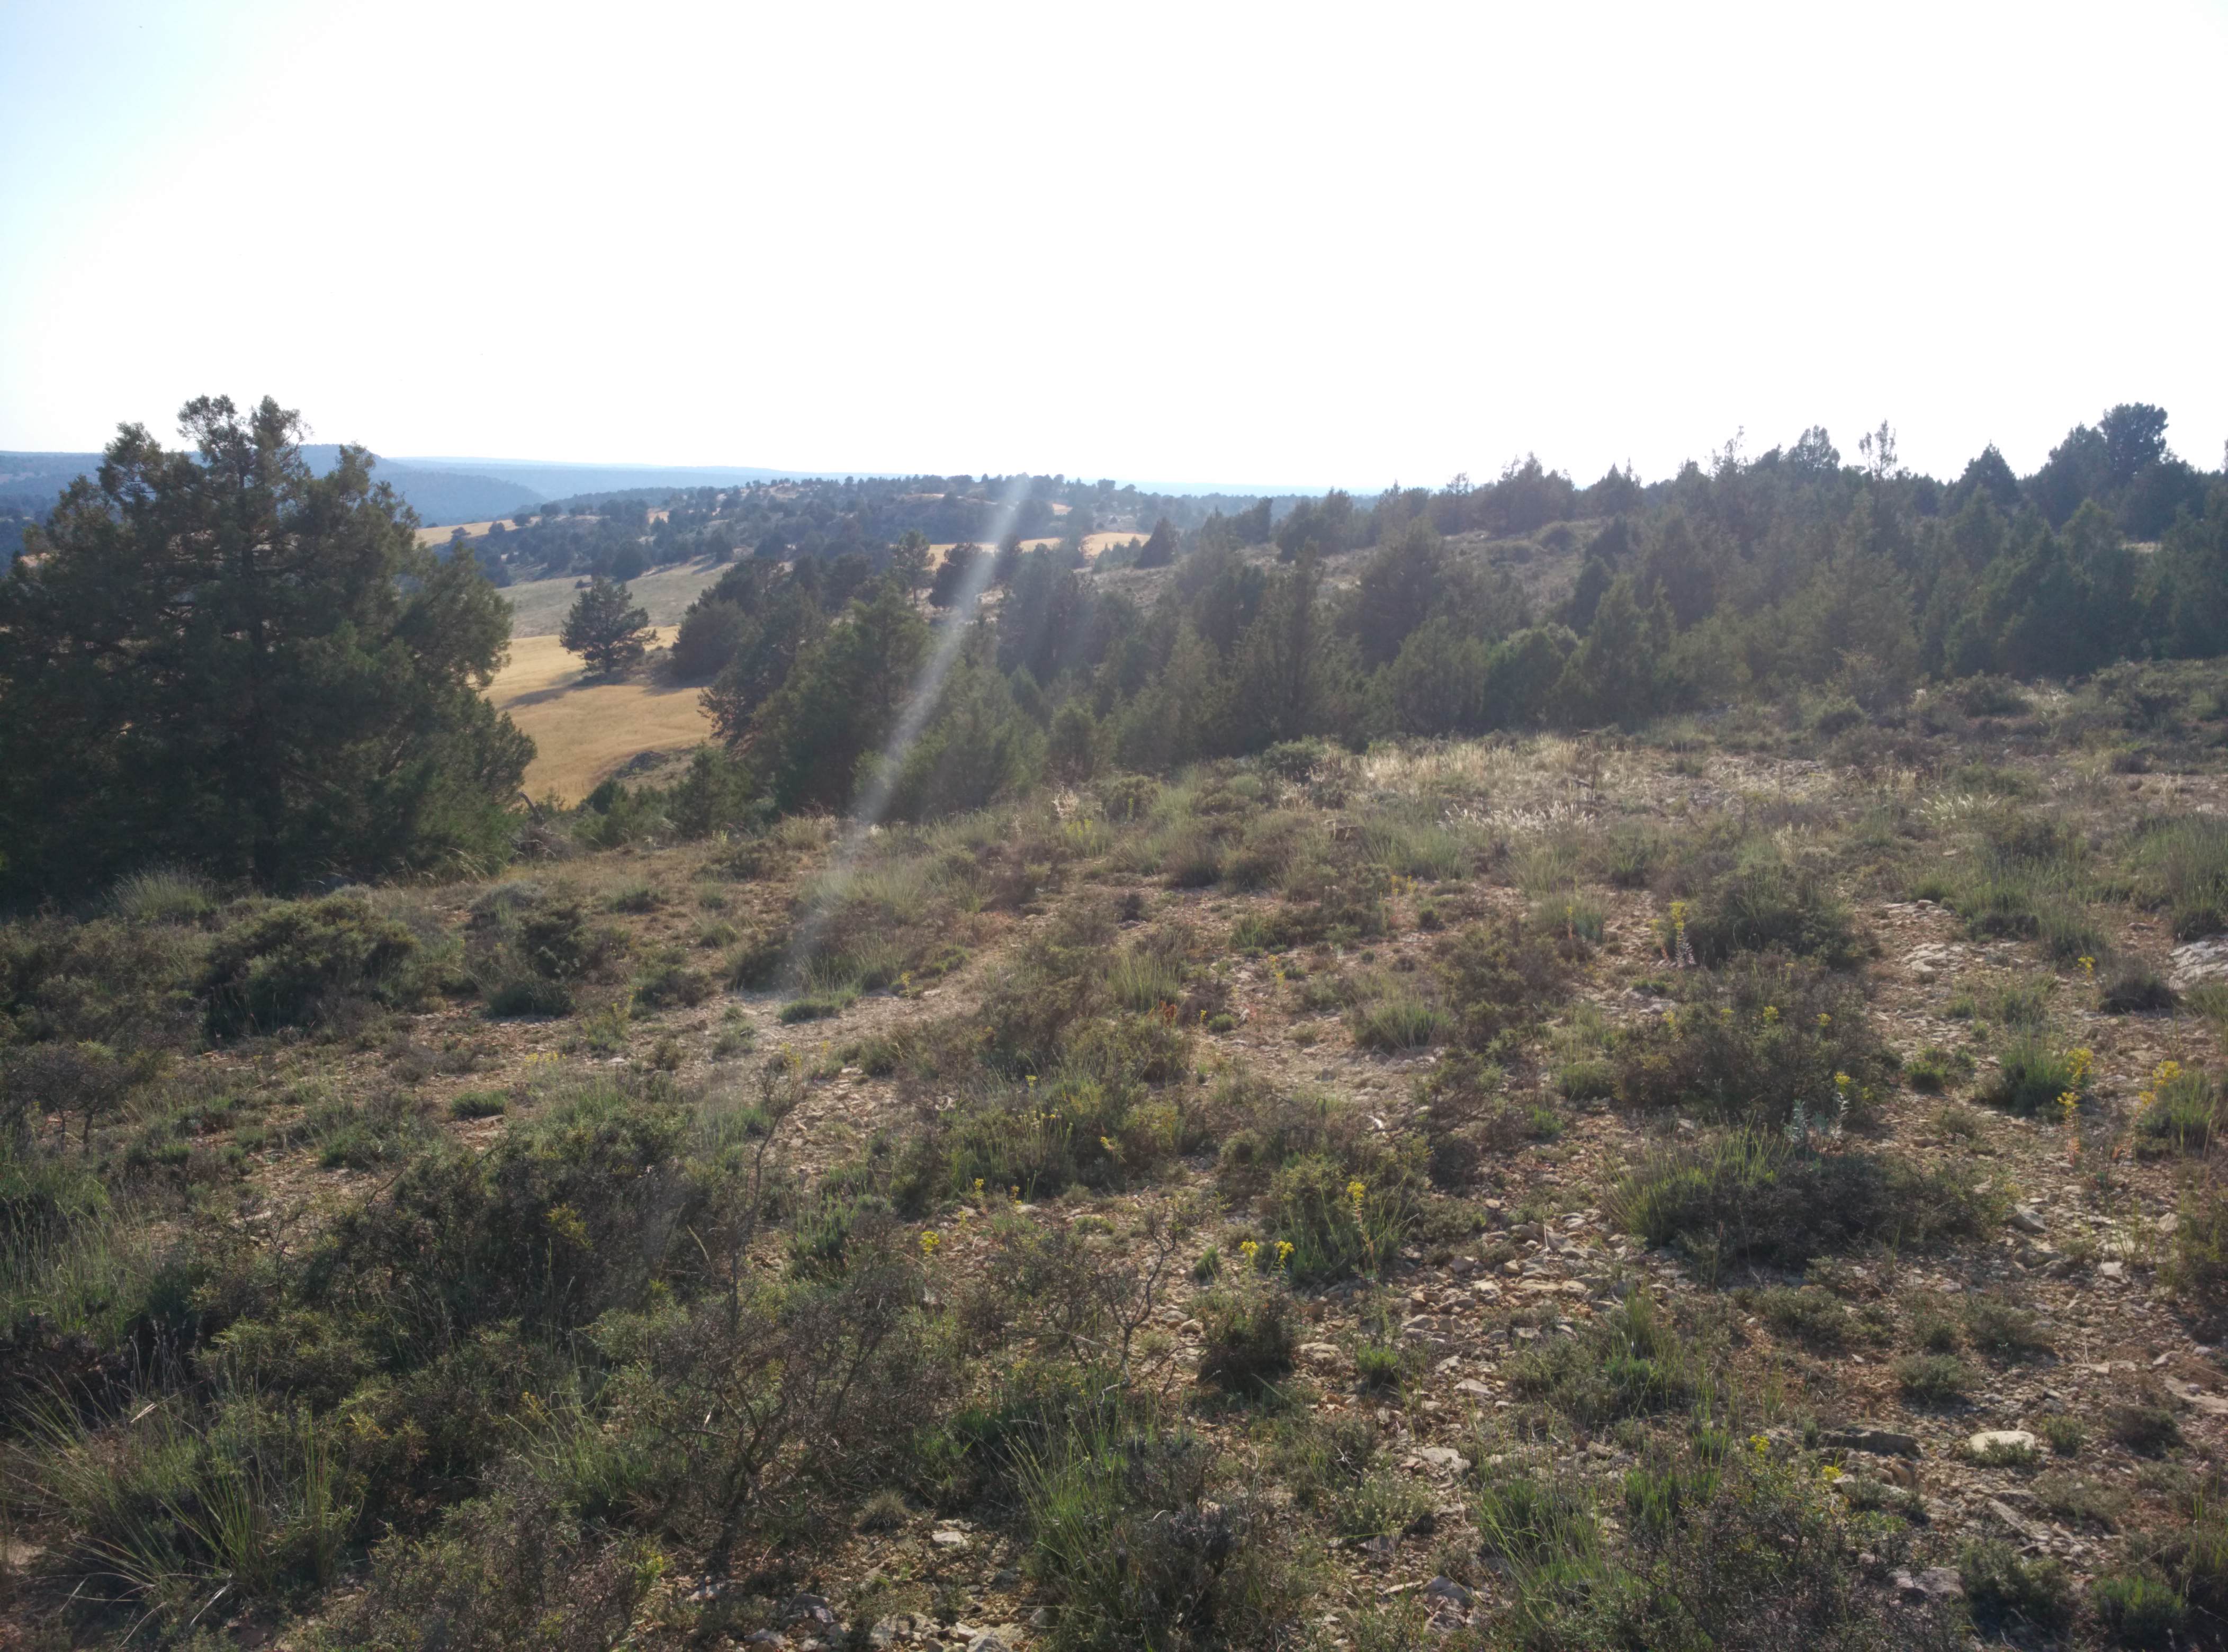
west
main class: Shrubland
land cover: Shrubland with sparse tree cover
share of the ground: 25 - 50 %
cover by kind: unconsolidated bare surface 50 %, shrubs 40 %, coniferous forest trees 5 %, herbaceous plants 5 %
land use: Semi-natural and natural areas not in use
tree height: > 5 m
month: June
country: ES
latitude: 40.7757
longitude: -1.9534
